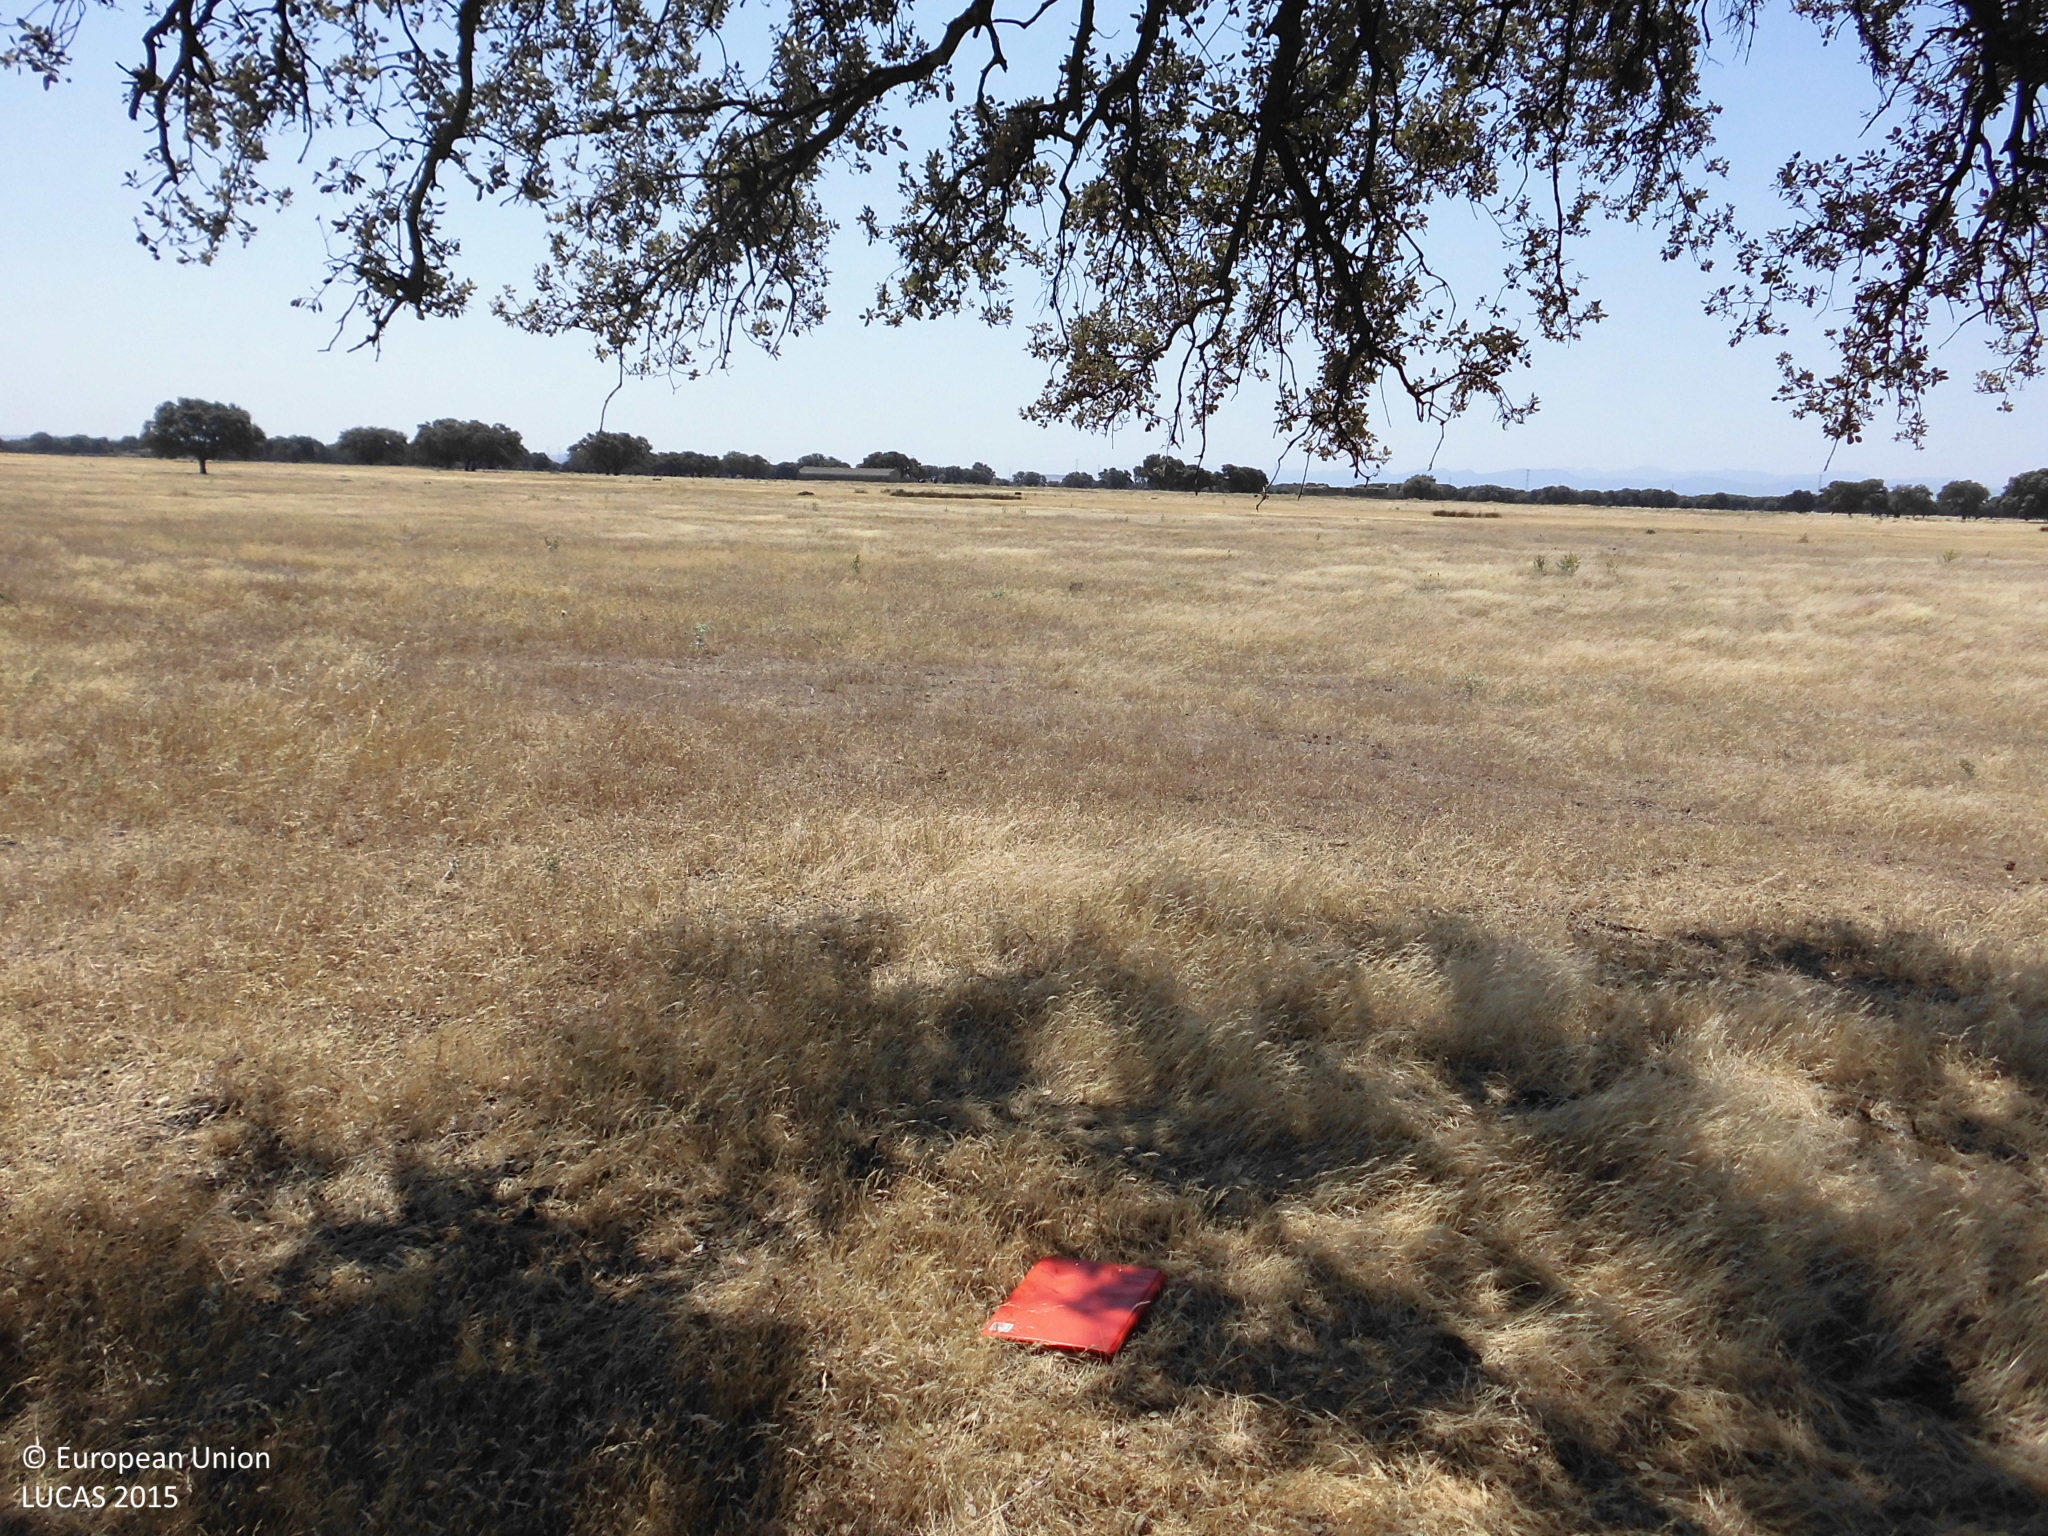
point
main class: Woodland
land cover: Broadleaved woodland
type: broadleaved evergreen forest
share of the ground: 10 - 25 %
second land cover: Grassland without tree/shrub cover
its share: > 75 %
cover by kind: herbaceous plants 90 %, broadleaved forest trees 10 %
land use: Forestry
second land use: Agriculture (excluding fallow land and kitchen gardens)
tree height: > 5 m
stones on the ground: < 10 %
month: June
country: ES
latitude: 39.9437
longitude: -5.4007
